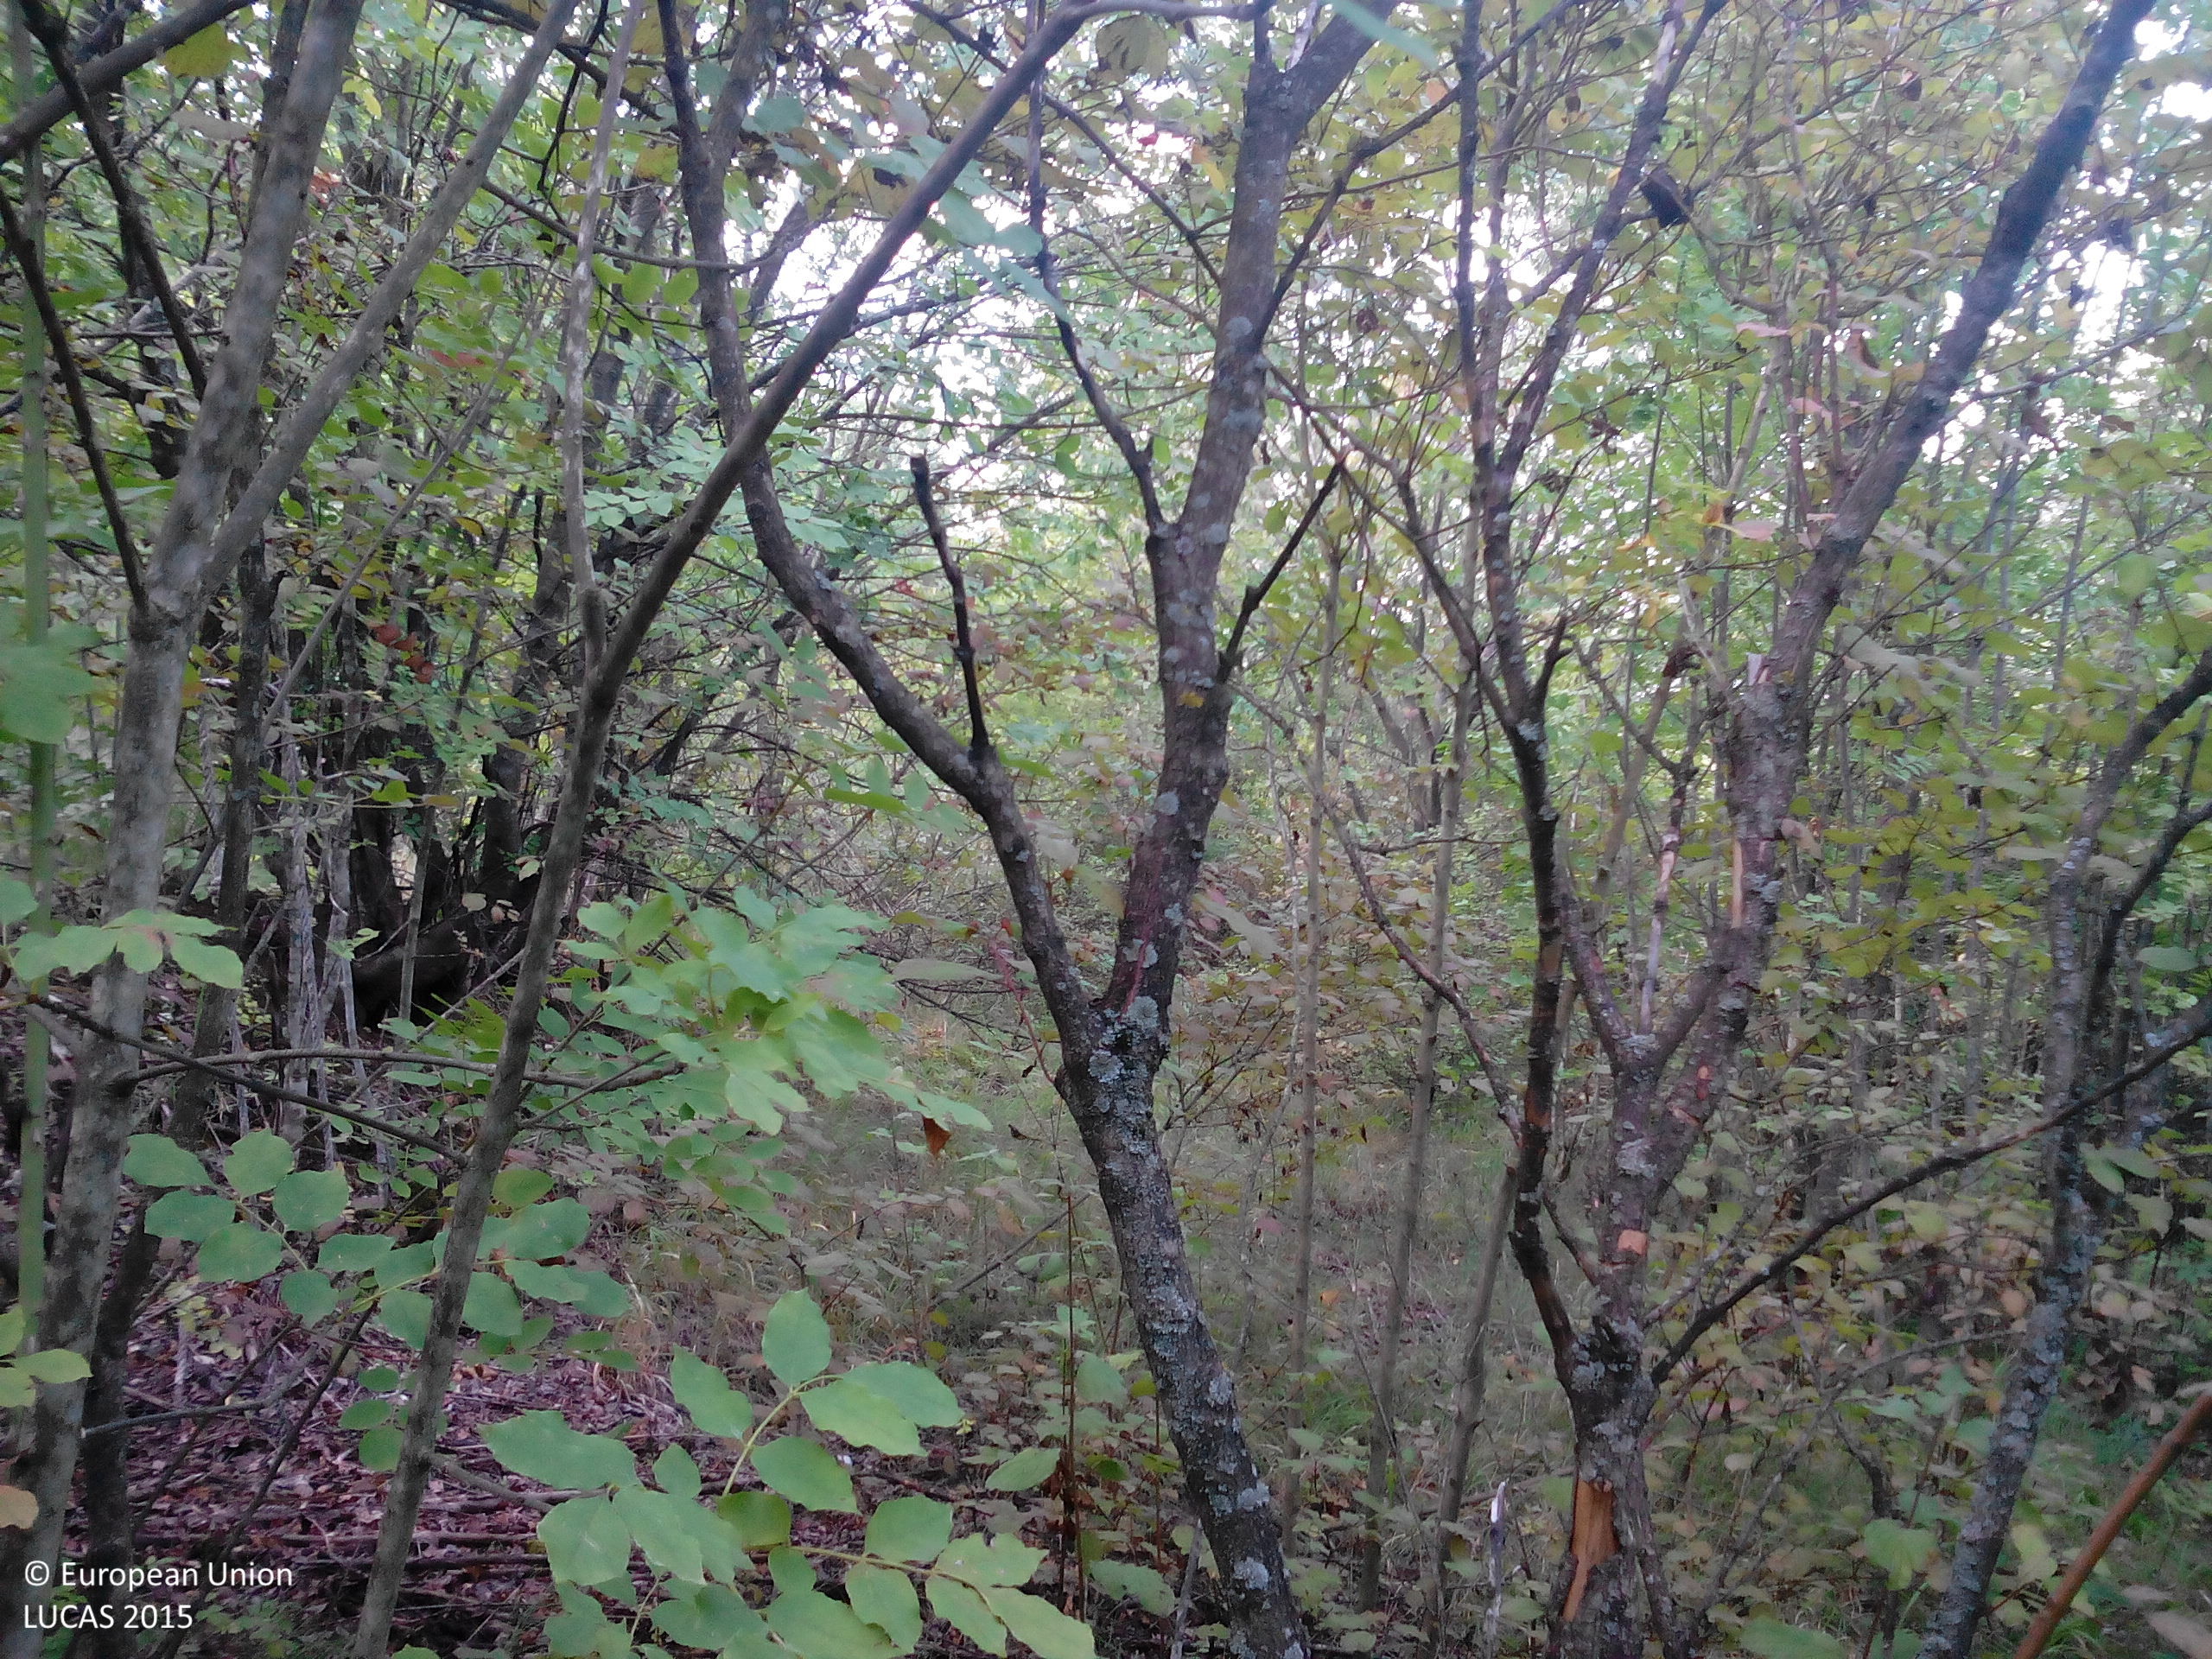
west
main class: Woodland
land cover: Broadleaved woodland
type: beech forest
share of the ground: > 75 %
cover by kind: broadleaved forest trees 100 %
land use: Forestry
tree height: > 5 m
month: October
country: BG
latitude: 43.2324
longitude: 23.7257
